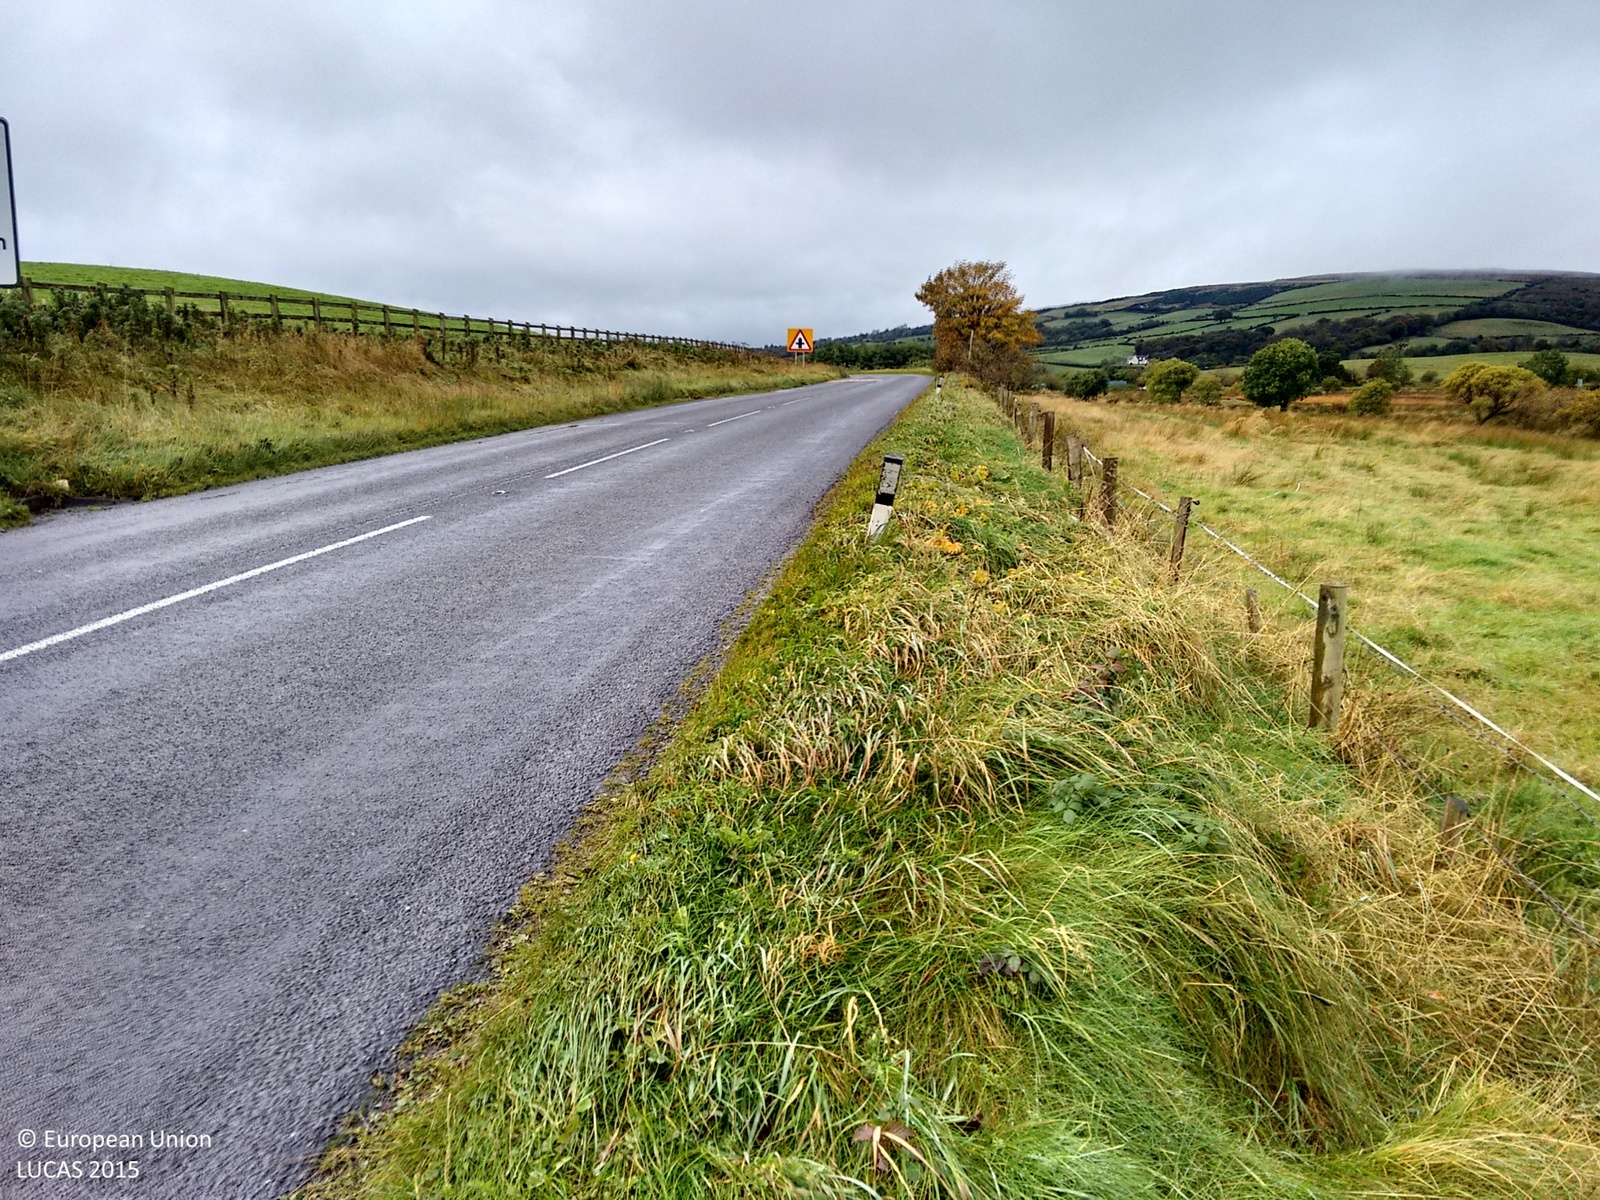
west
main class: Grassland
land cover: Grassland without tree/shrub cover
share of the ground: > 75 %
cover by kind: herbaceous plants 100 %
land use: Agriculture (excluding fallow land and kitchen gardens)
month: October
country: GB
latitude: 54.5481
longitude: -7.4853
